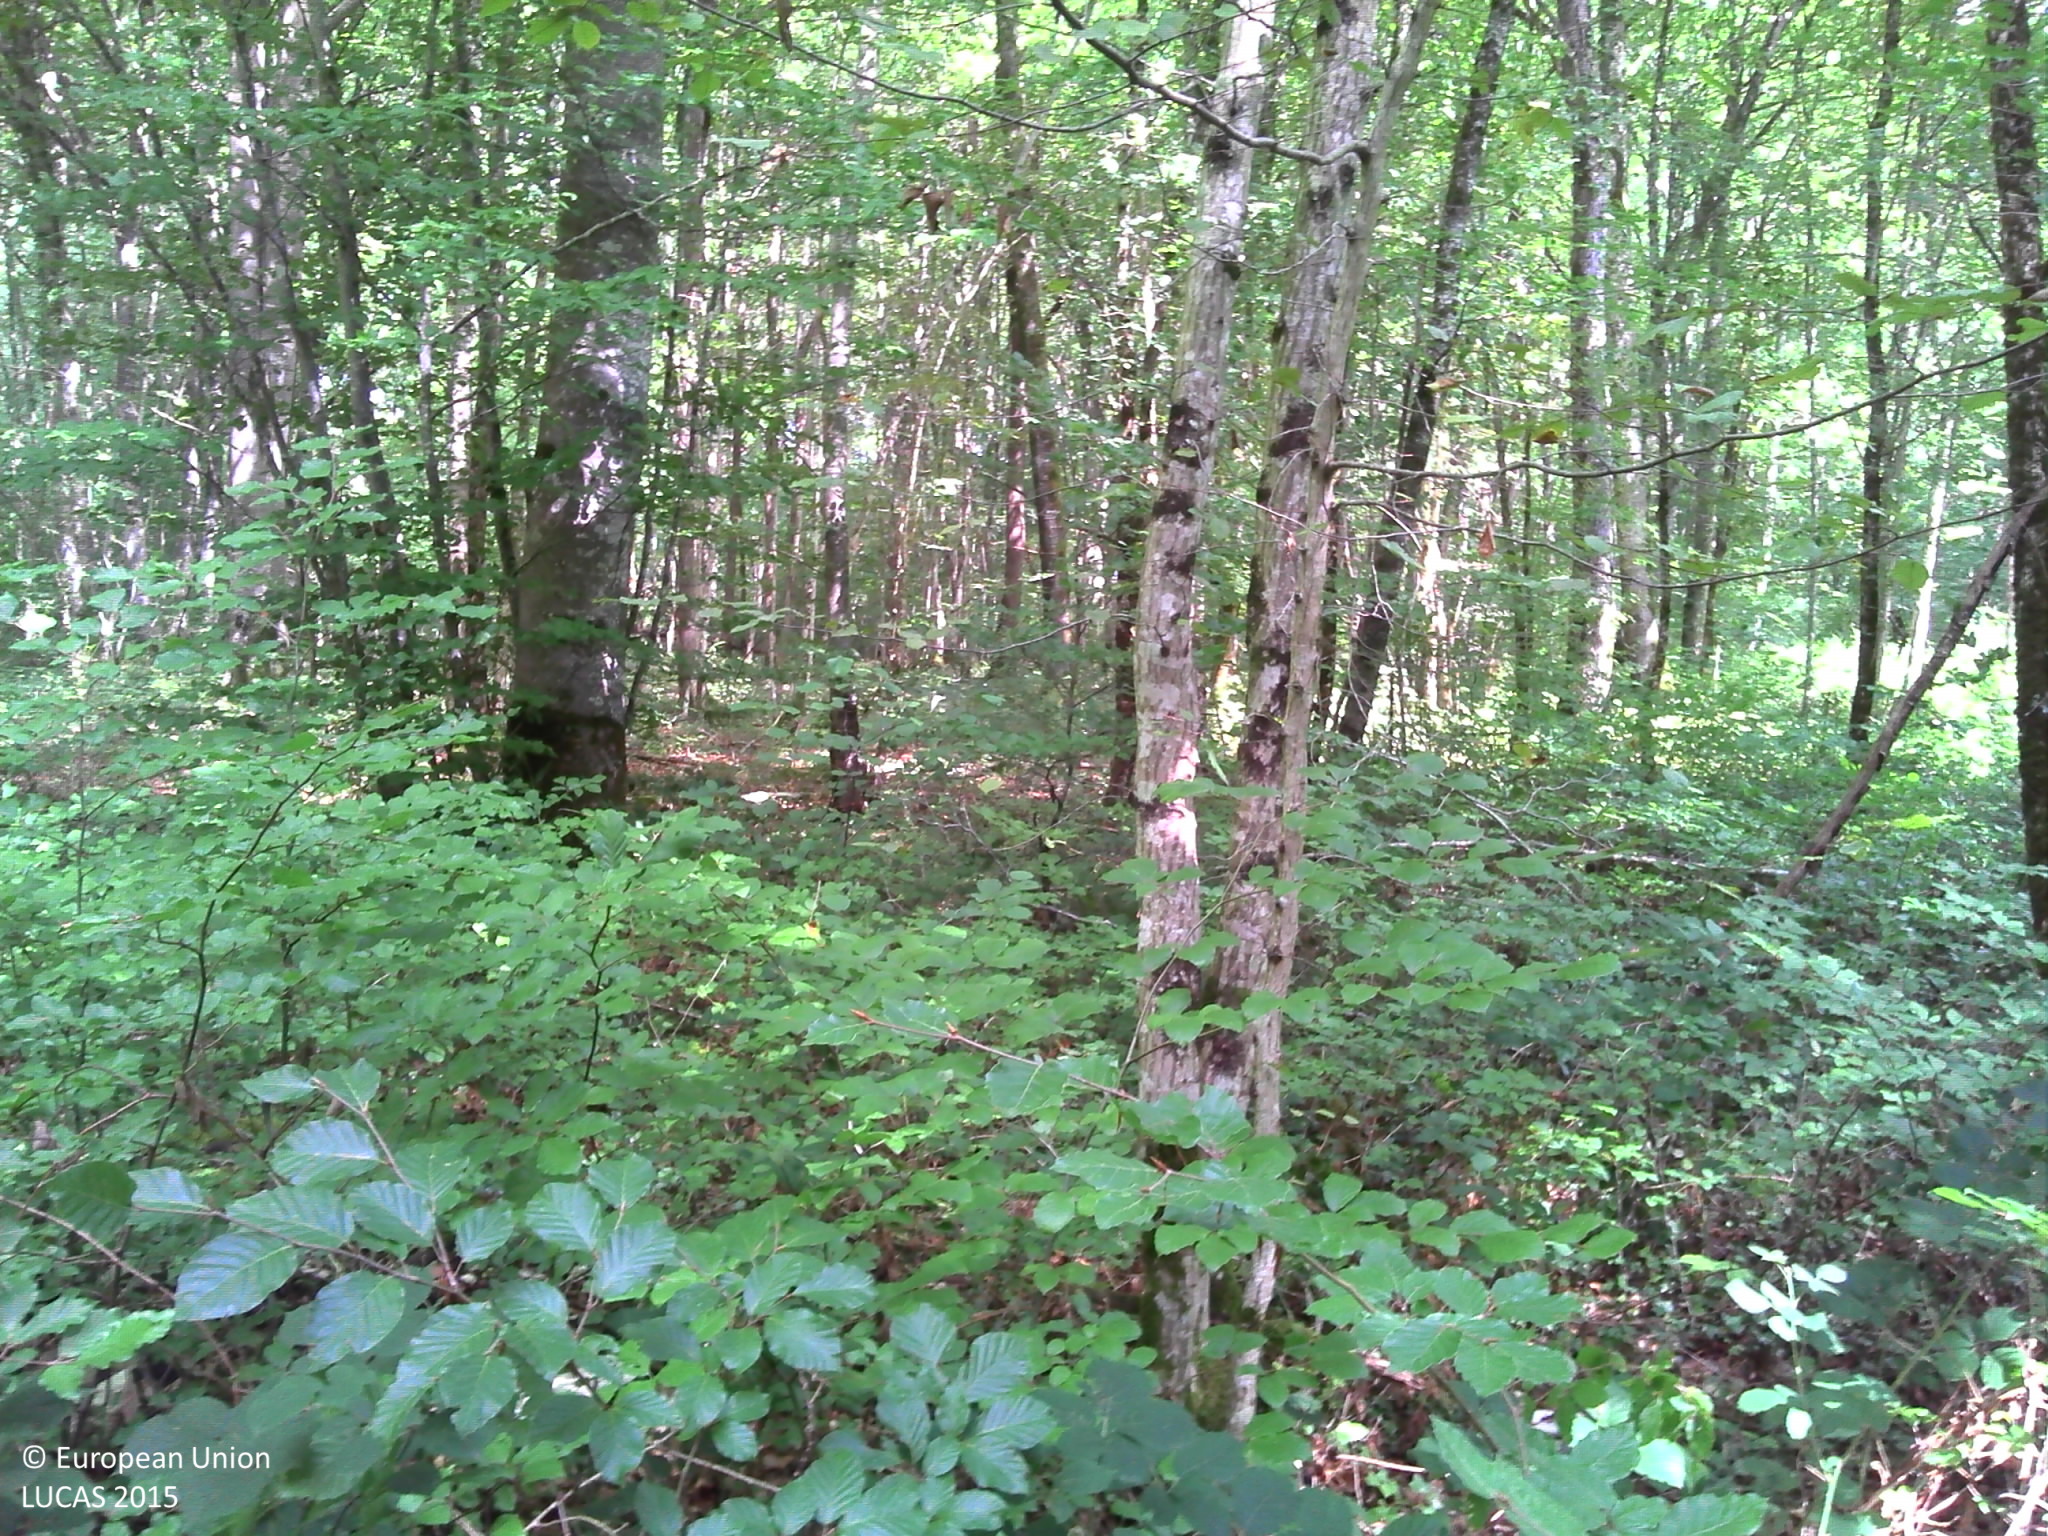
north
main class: Woodland
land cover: Broadleaved woodland
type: mesophytic deciduous forest
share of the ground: > 75 %
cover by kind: broadleaved forest trees 90 %, herbaceous plants 5 %, lichens and mosses 5 %
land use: Forestry
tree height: > 5 m
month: August
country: FR
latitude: 47.8472
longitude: 4.7739
